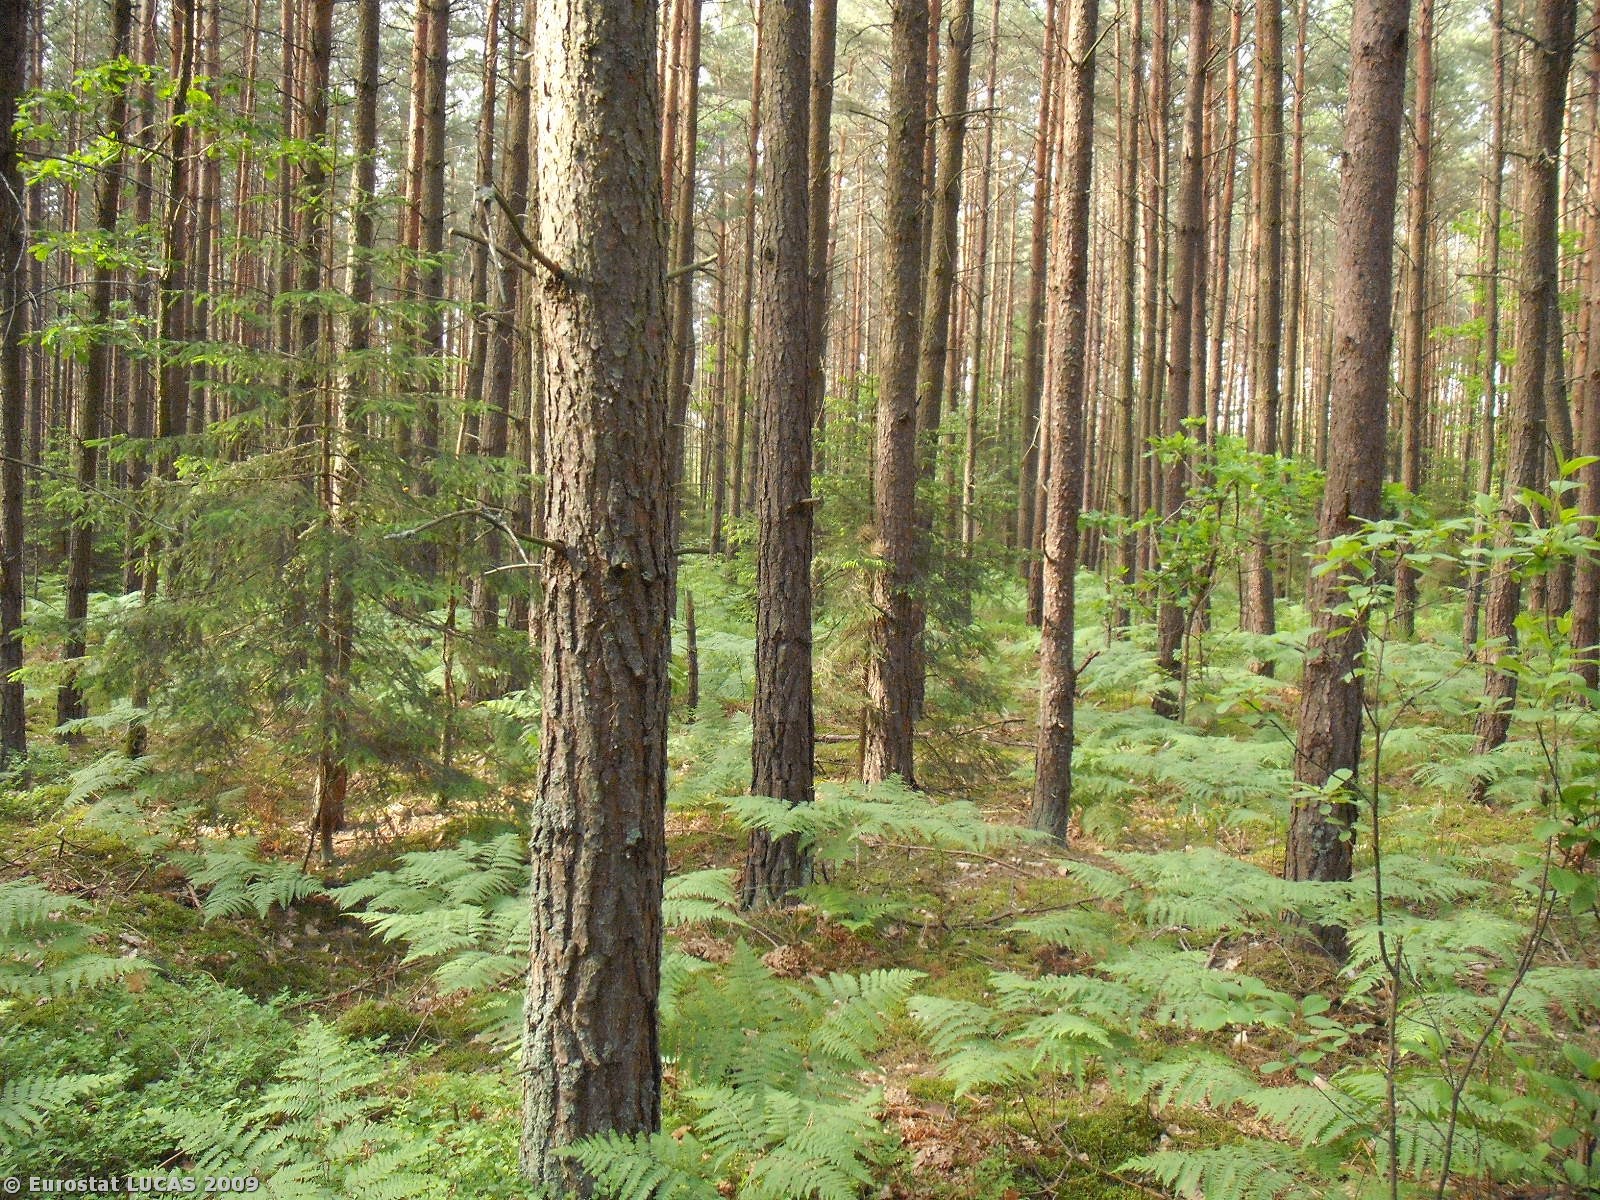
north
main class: Woodland
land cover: Coniferous woodland
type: hemiboreal forest and nemoral coniferous forest and mixed broadleaved-coniferous forest
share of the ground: > 75 %
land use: Forestry
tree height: > 5 m
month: June
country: PL
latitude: 51.3301
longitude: 20.5010
